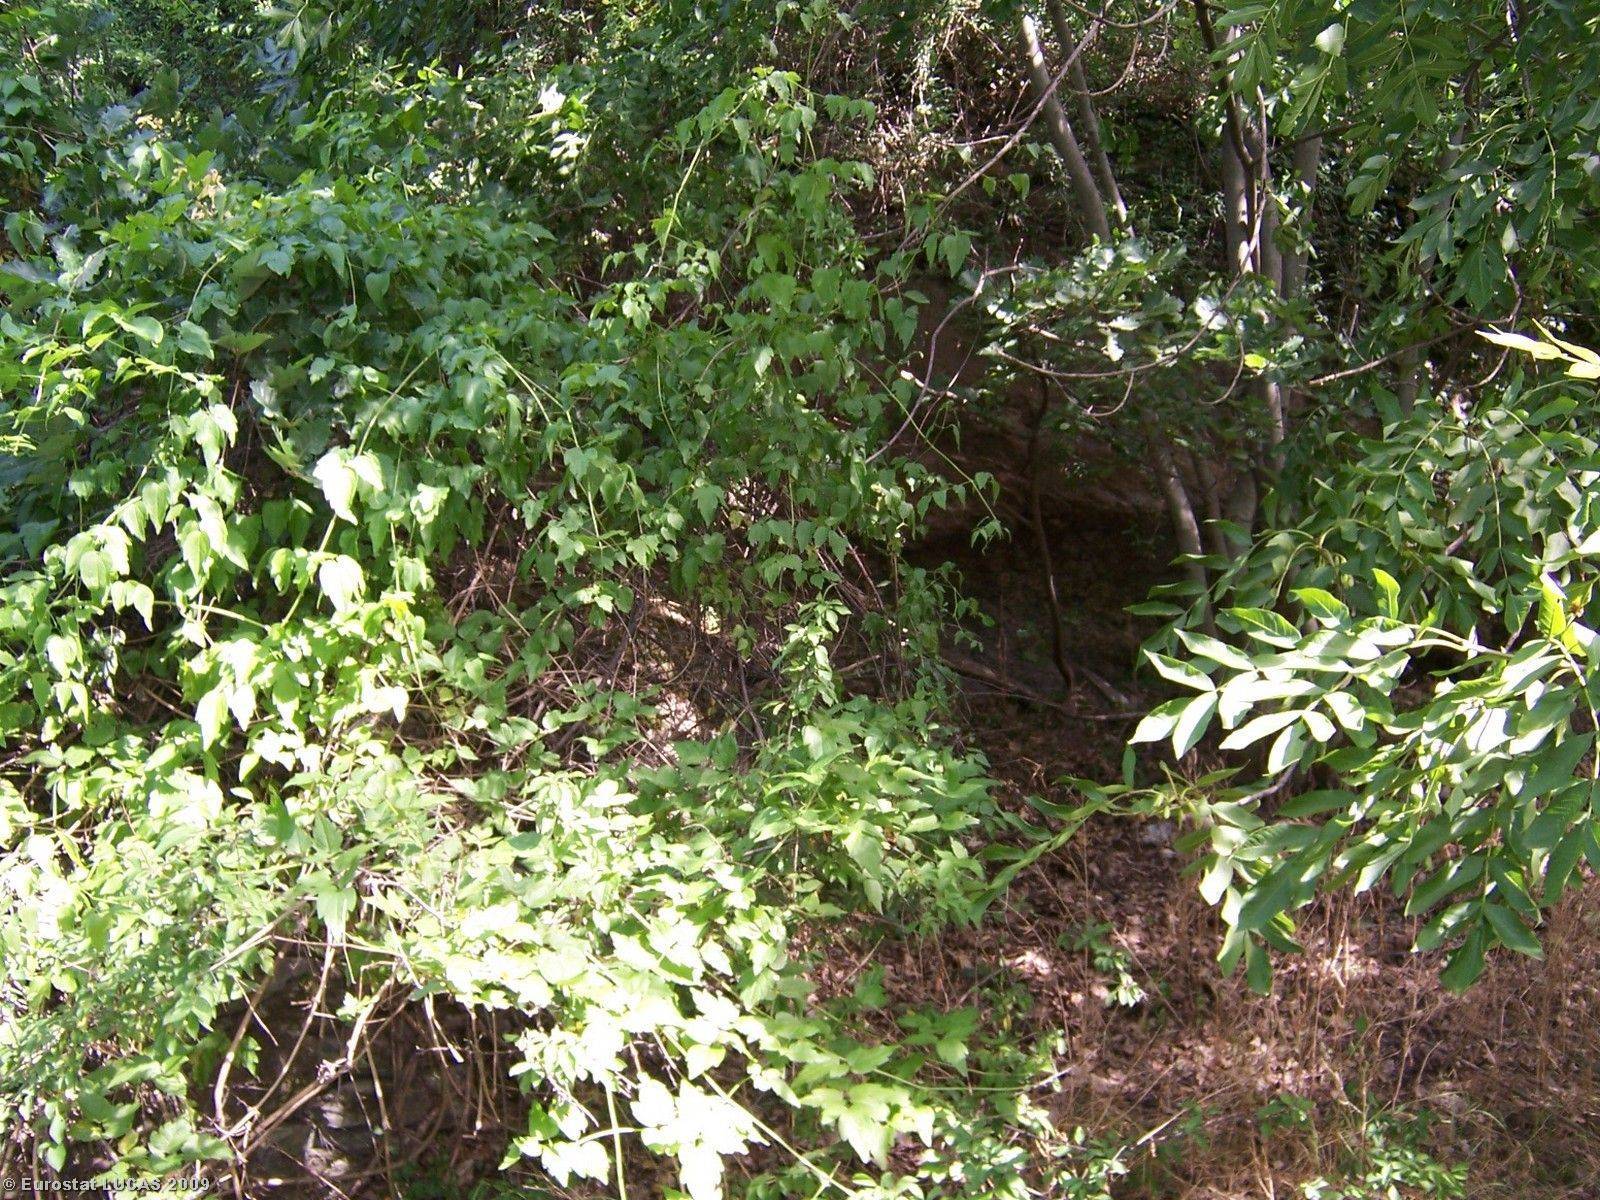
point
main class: Woodland
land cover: Broadleaved woodland
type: mesophytic deciduous forest
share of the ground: > 75 %
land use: Unused
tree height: > 5 m
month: July
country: IT
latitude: 45.1218
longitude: 7.0935
